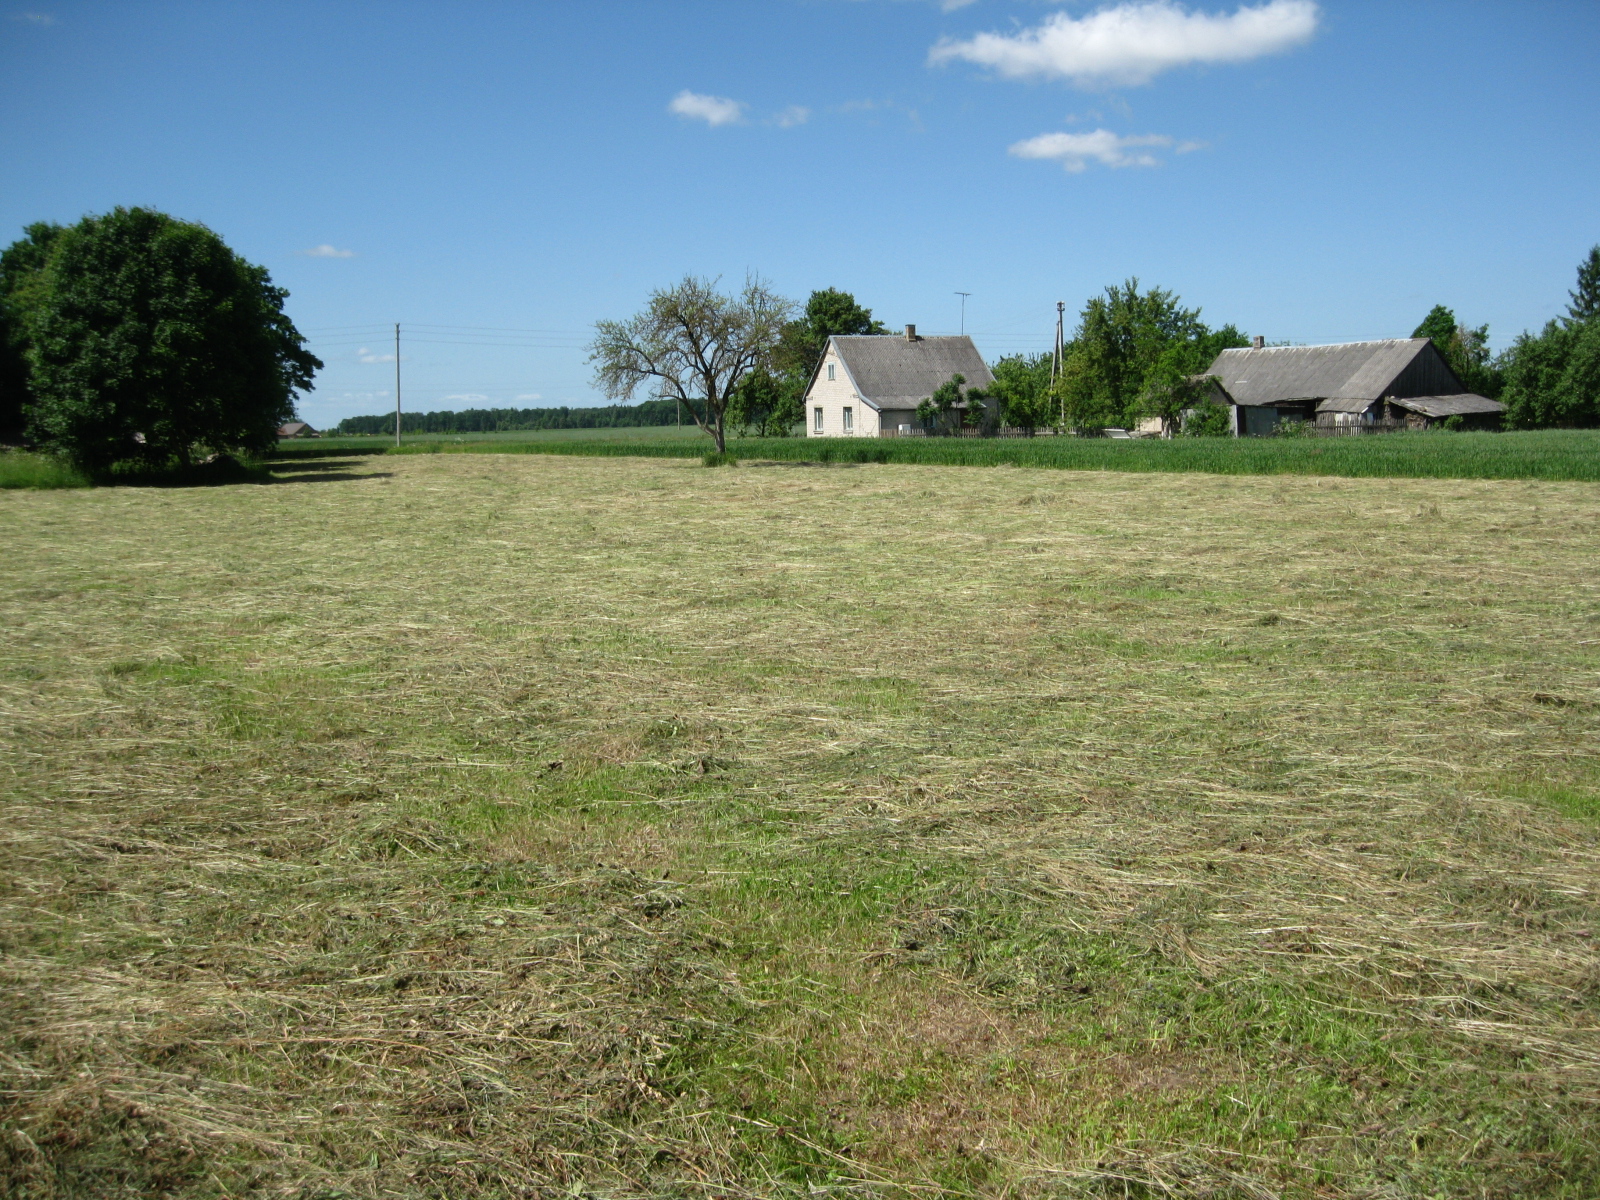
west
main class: Grassland
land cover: Grassland without tree/shrub cover
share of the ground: > 75 %
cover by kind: herbaceous plants 100 %
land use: Agriculture (excluding fallow land and kitchen gardens)
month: June
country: LT
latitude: 55.2137
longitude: 23.8389
